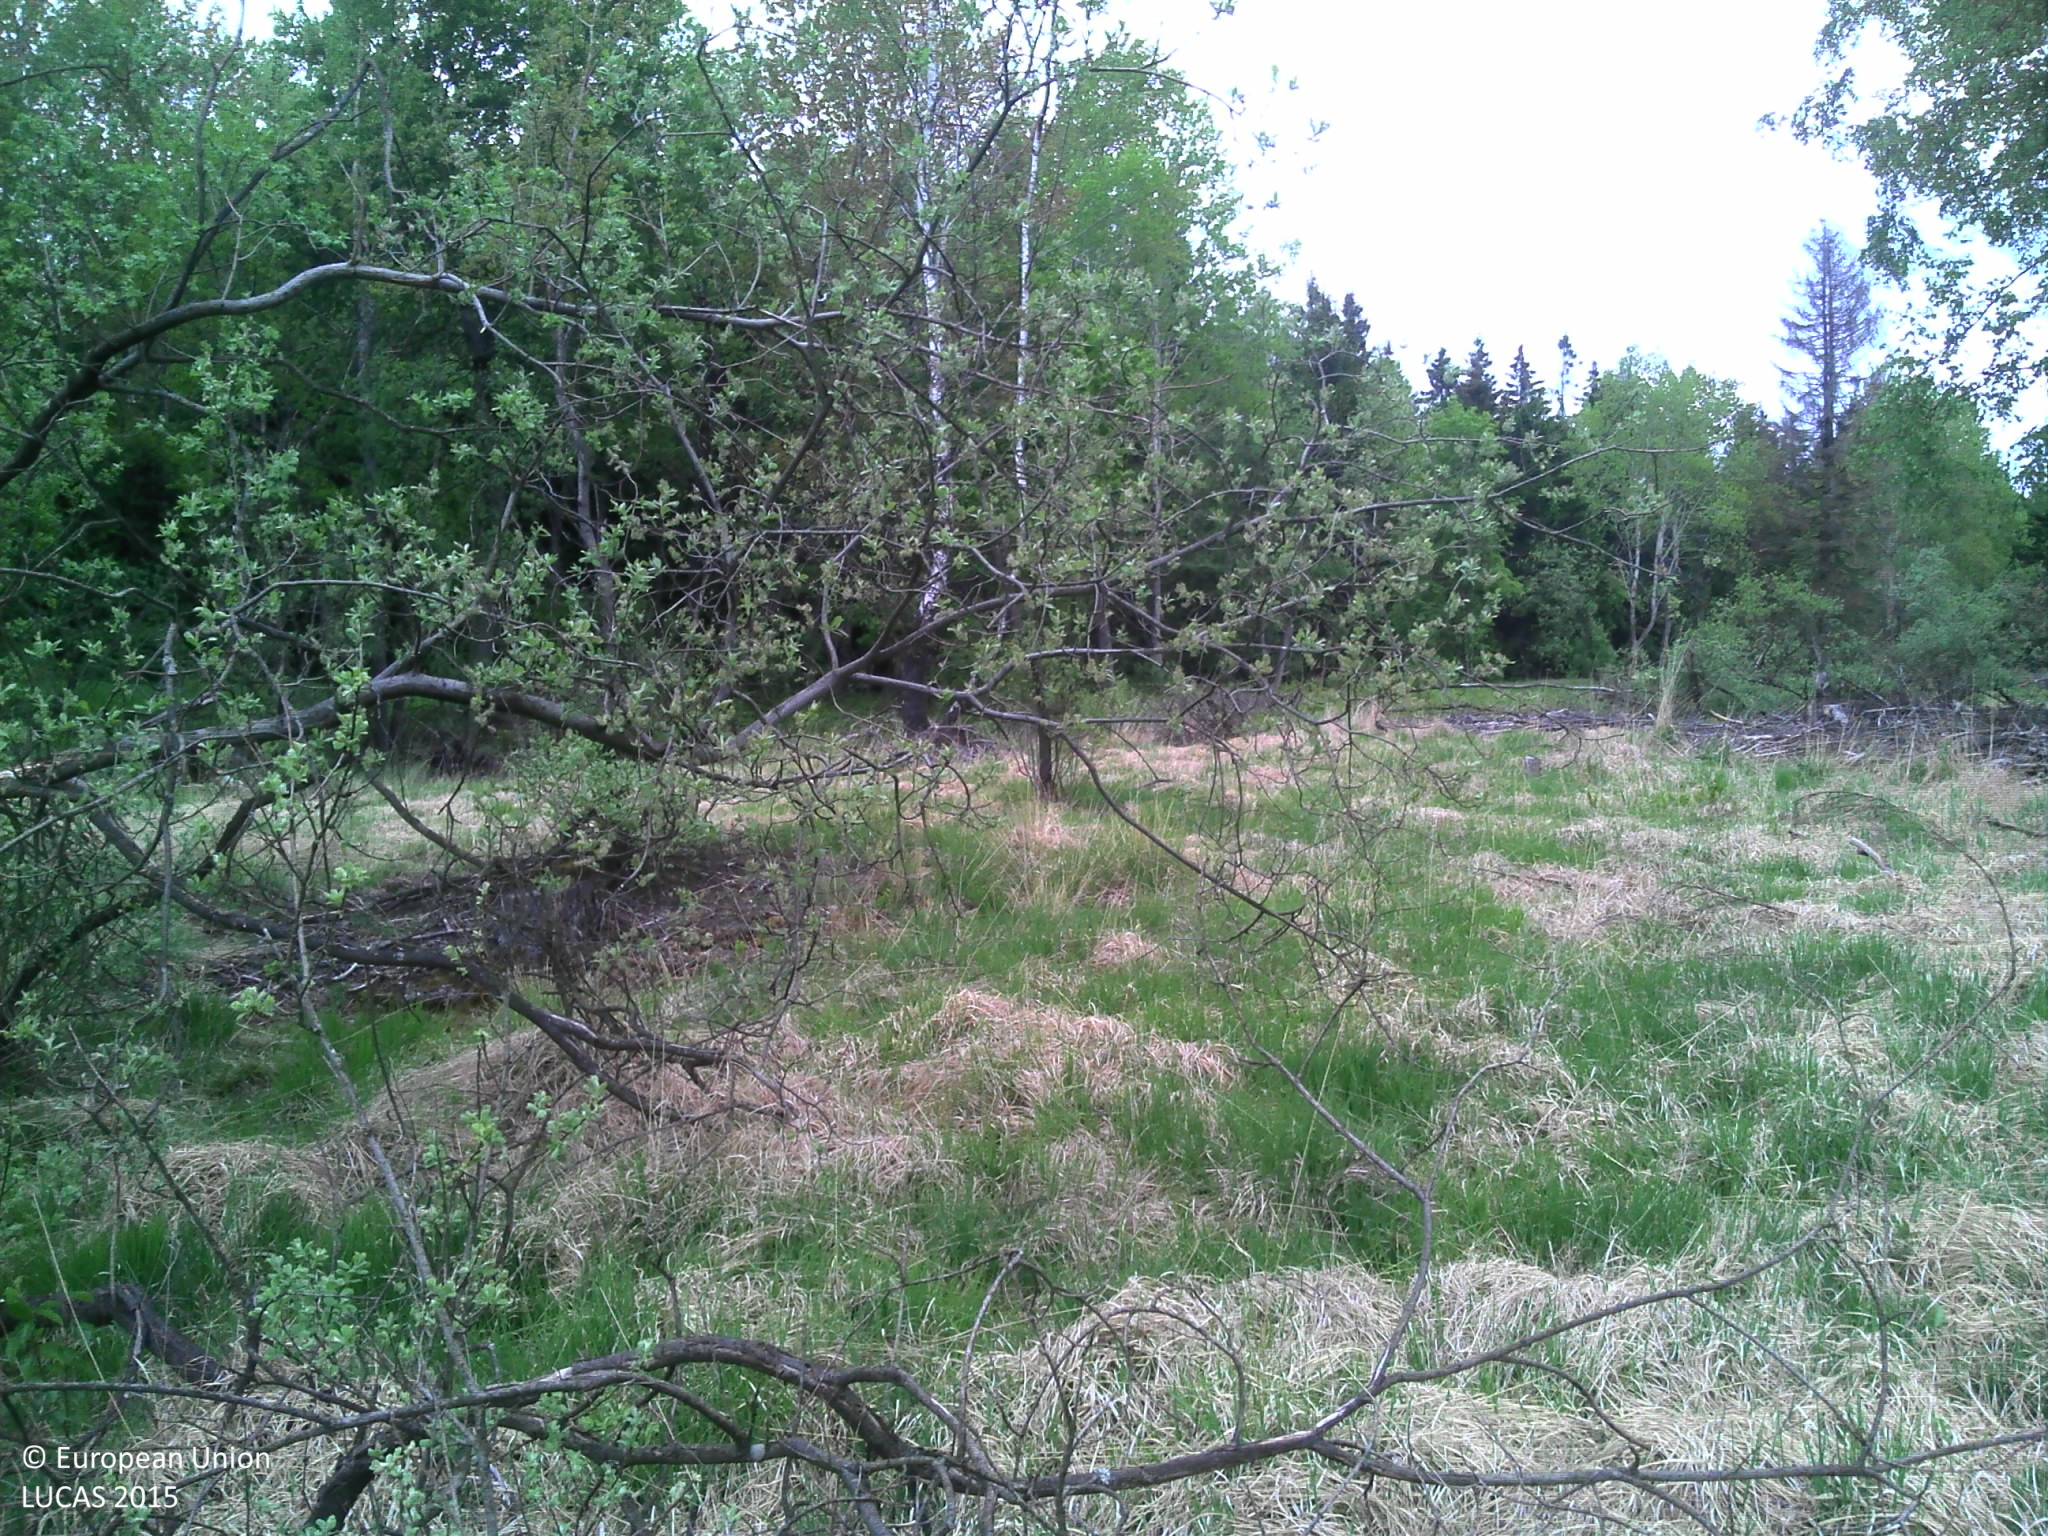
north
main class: Shrubland
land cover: Shrubland with sparse tree cover
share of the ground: > 75 %
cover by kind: herbaceous plants 80 %, shrubs 15 %, broadleaved forest trees 5 %
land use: Forestry
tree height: > 5 m
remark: Temporary flooded
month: May
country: BE
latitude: 50.6088
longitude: 6.2546
